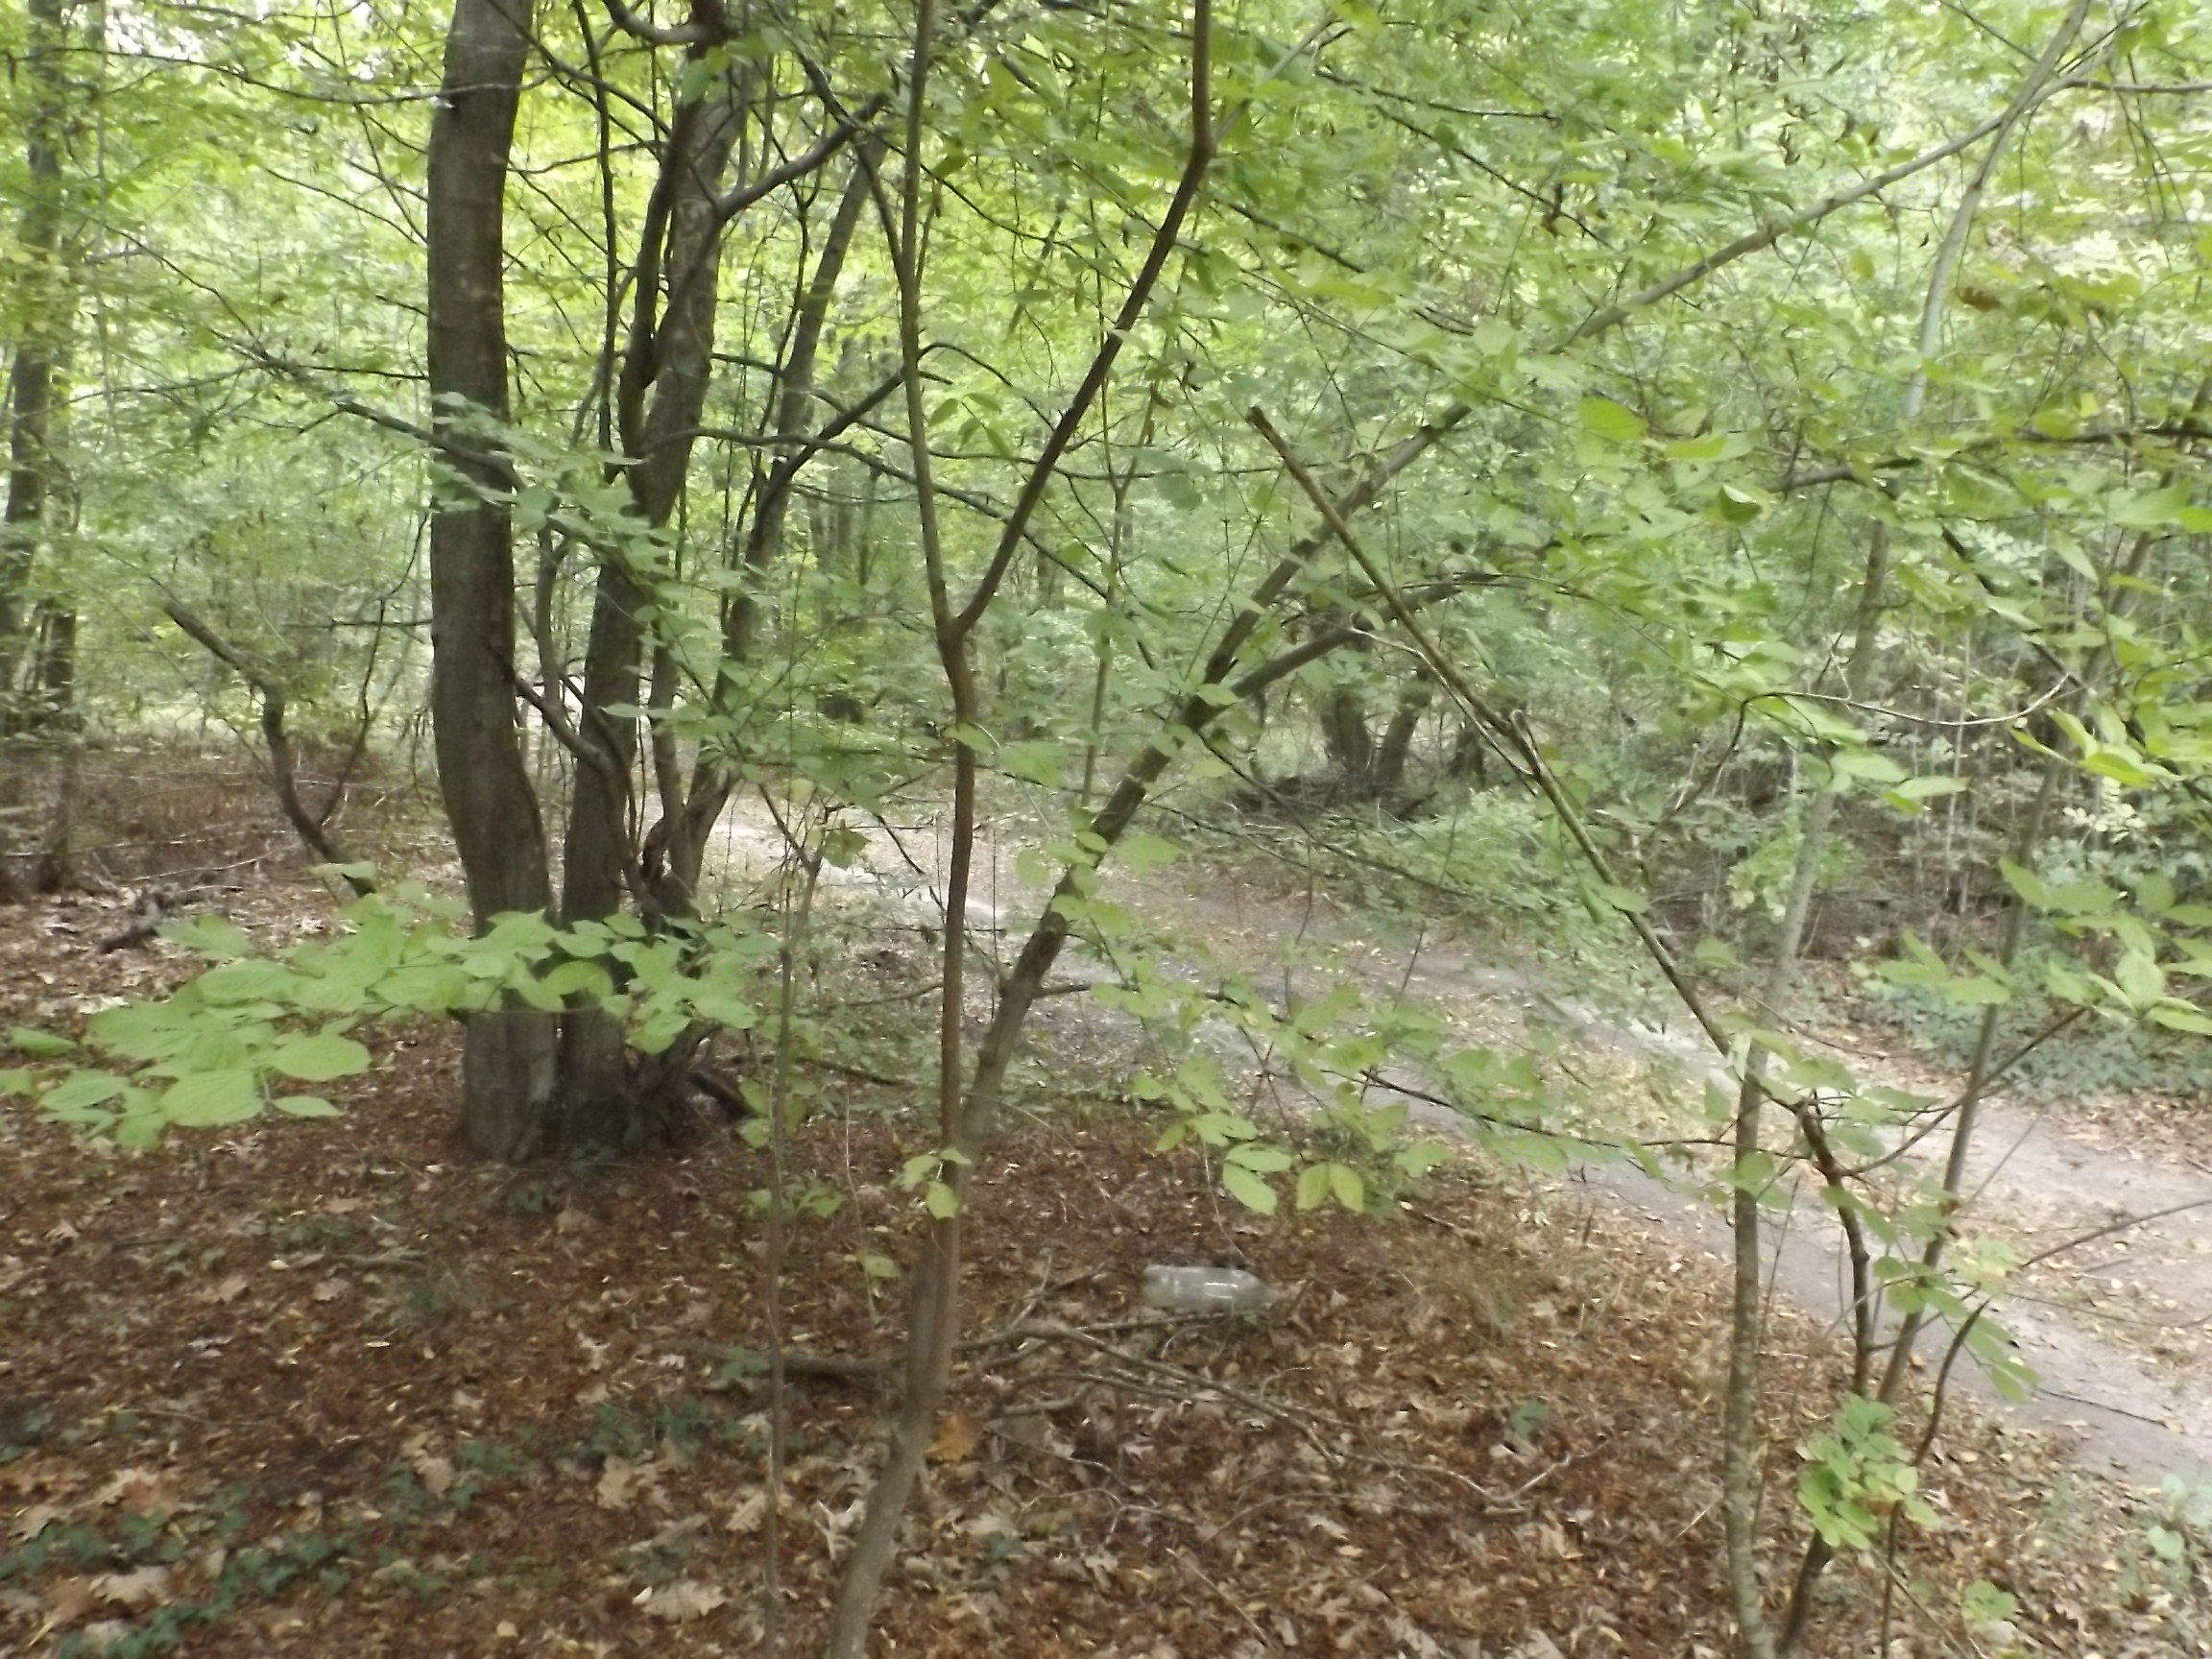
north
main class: Woodland
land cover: Broadleaved woodland
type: beech forest
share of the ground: > 75 %
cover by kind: broadleaved forest trees 100 %
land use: Forestry
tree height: > 5 m
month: October
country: BG
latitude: 42.9455
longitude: 27.8938
